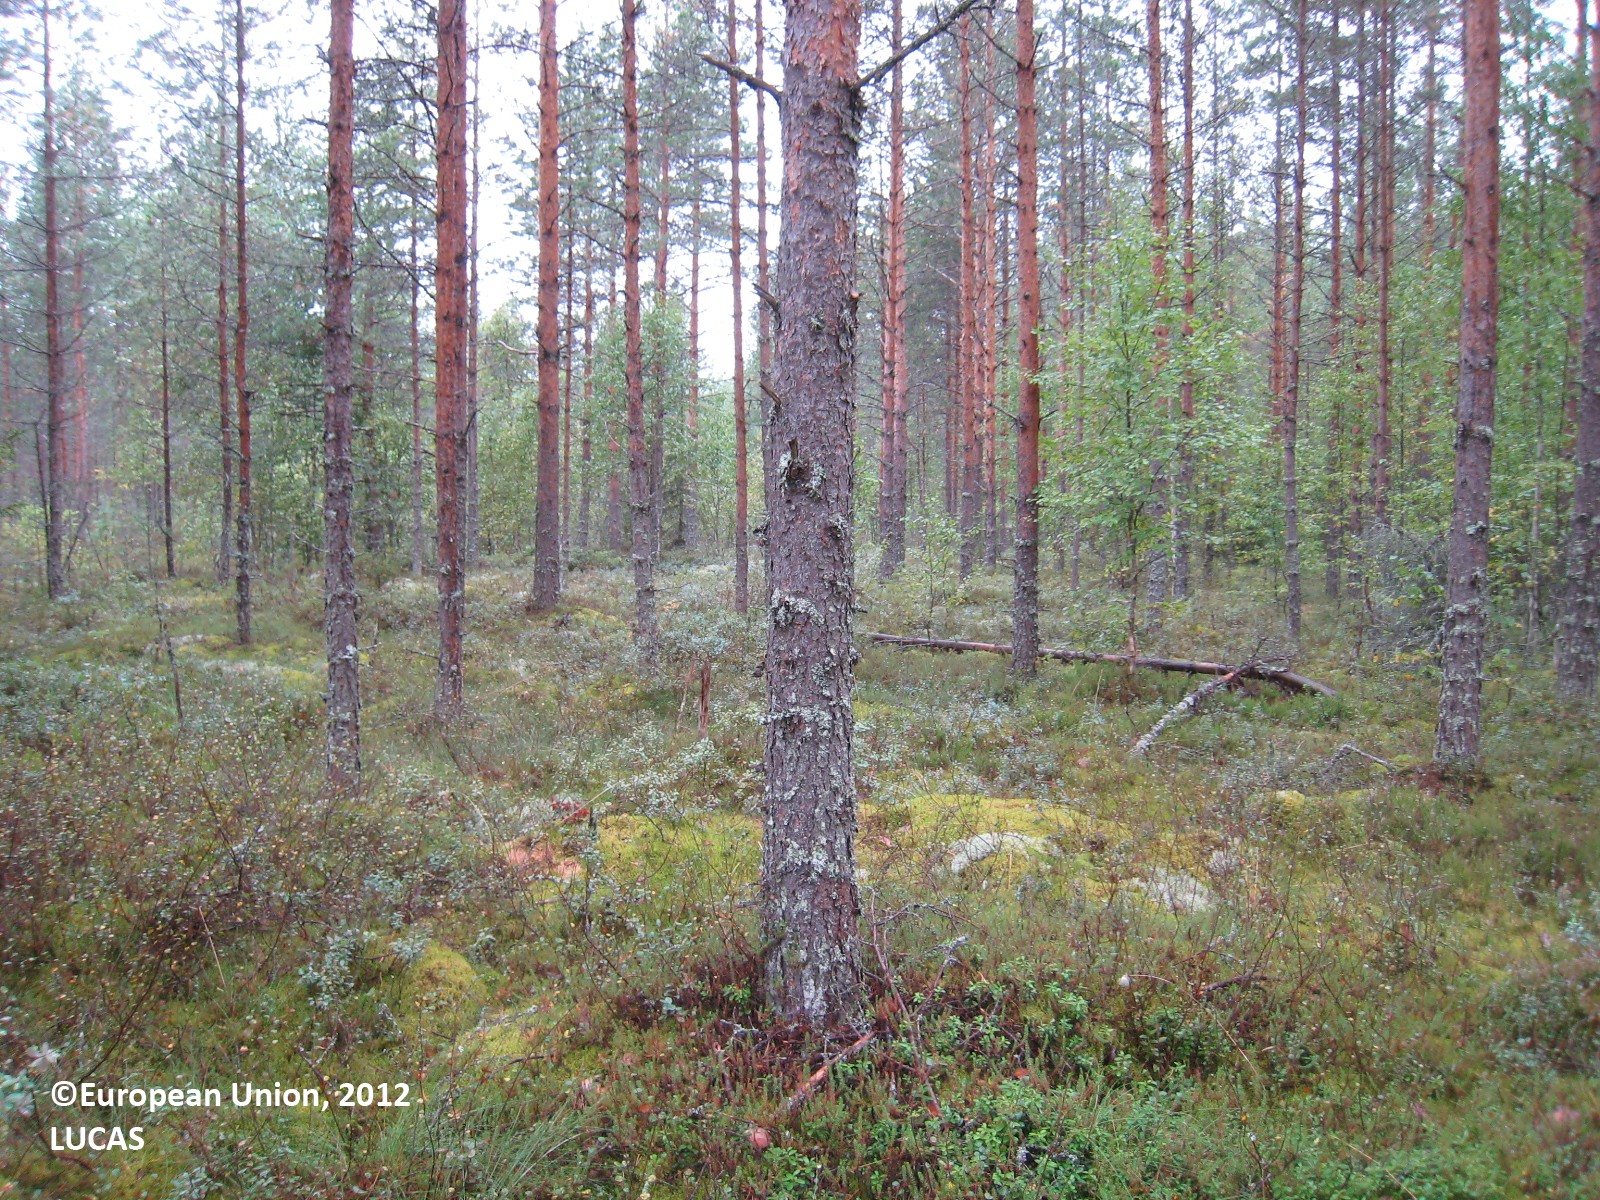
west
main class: Woodland
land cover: Pine dominated coniferous woodland
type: mire and swamp forests
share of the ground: 50 - 75 %
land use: Forestry
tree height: > 5 m
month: August
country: FI
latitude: 61.9083
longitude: 26.2218
